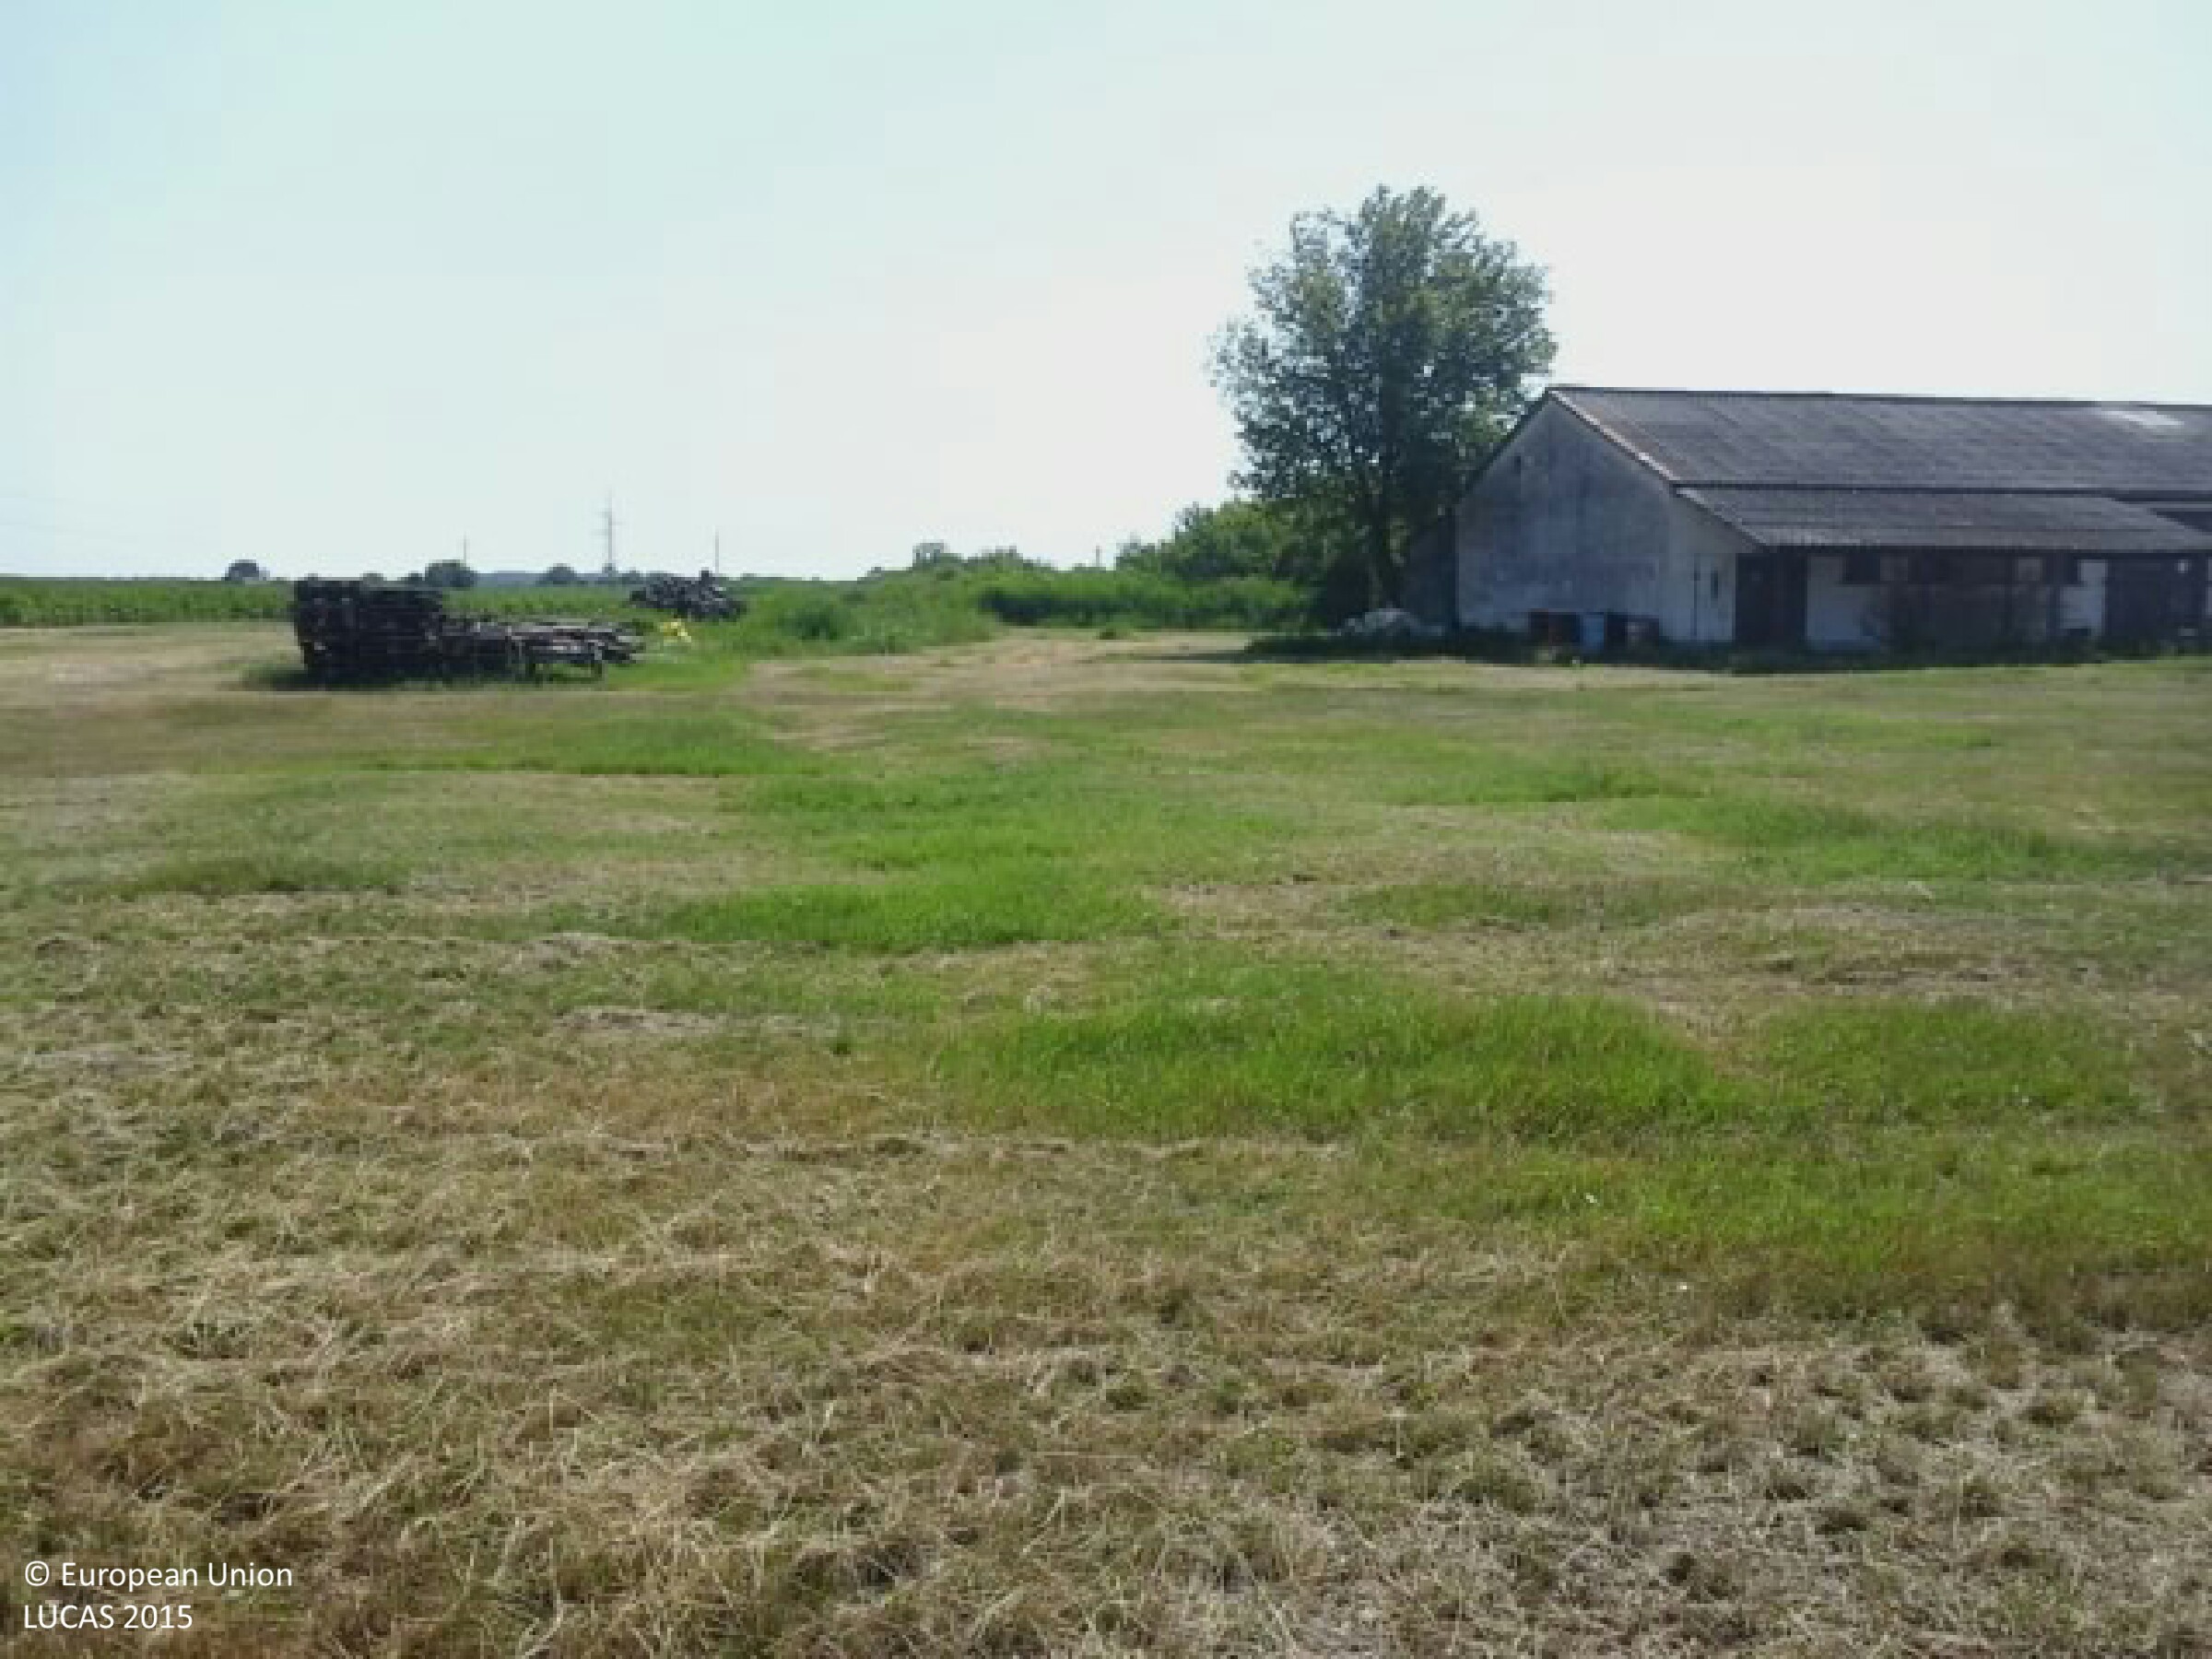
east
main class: Grassland
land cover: Grassland without tree/shrub cover
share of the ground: > 75 %
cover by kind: herbaceous plants 100 %
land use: Agriculture (excluding fallow land and kitchen gardens)
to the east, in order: Grassland without tree/shrub cover; Single bushes/trees; Ditches and canals; Shruby margins; Lines of trees; Grass margins; Paved roads, cycling and walking lanes; Grass margins; Electric lines; Grassland without tree/shrub cover; Fences; Shruby margins; Grass margins; Paved roads, cycling and walking lanes; Grass margins
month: July
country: HU
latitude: 46.6657
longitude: 20.3379
